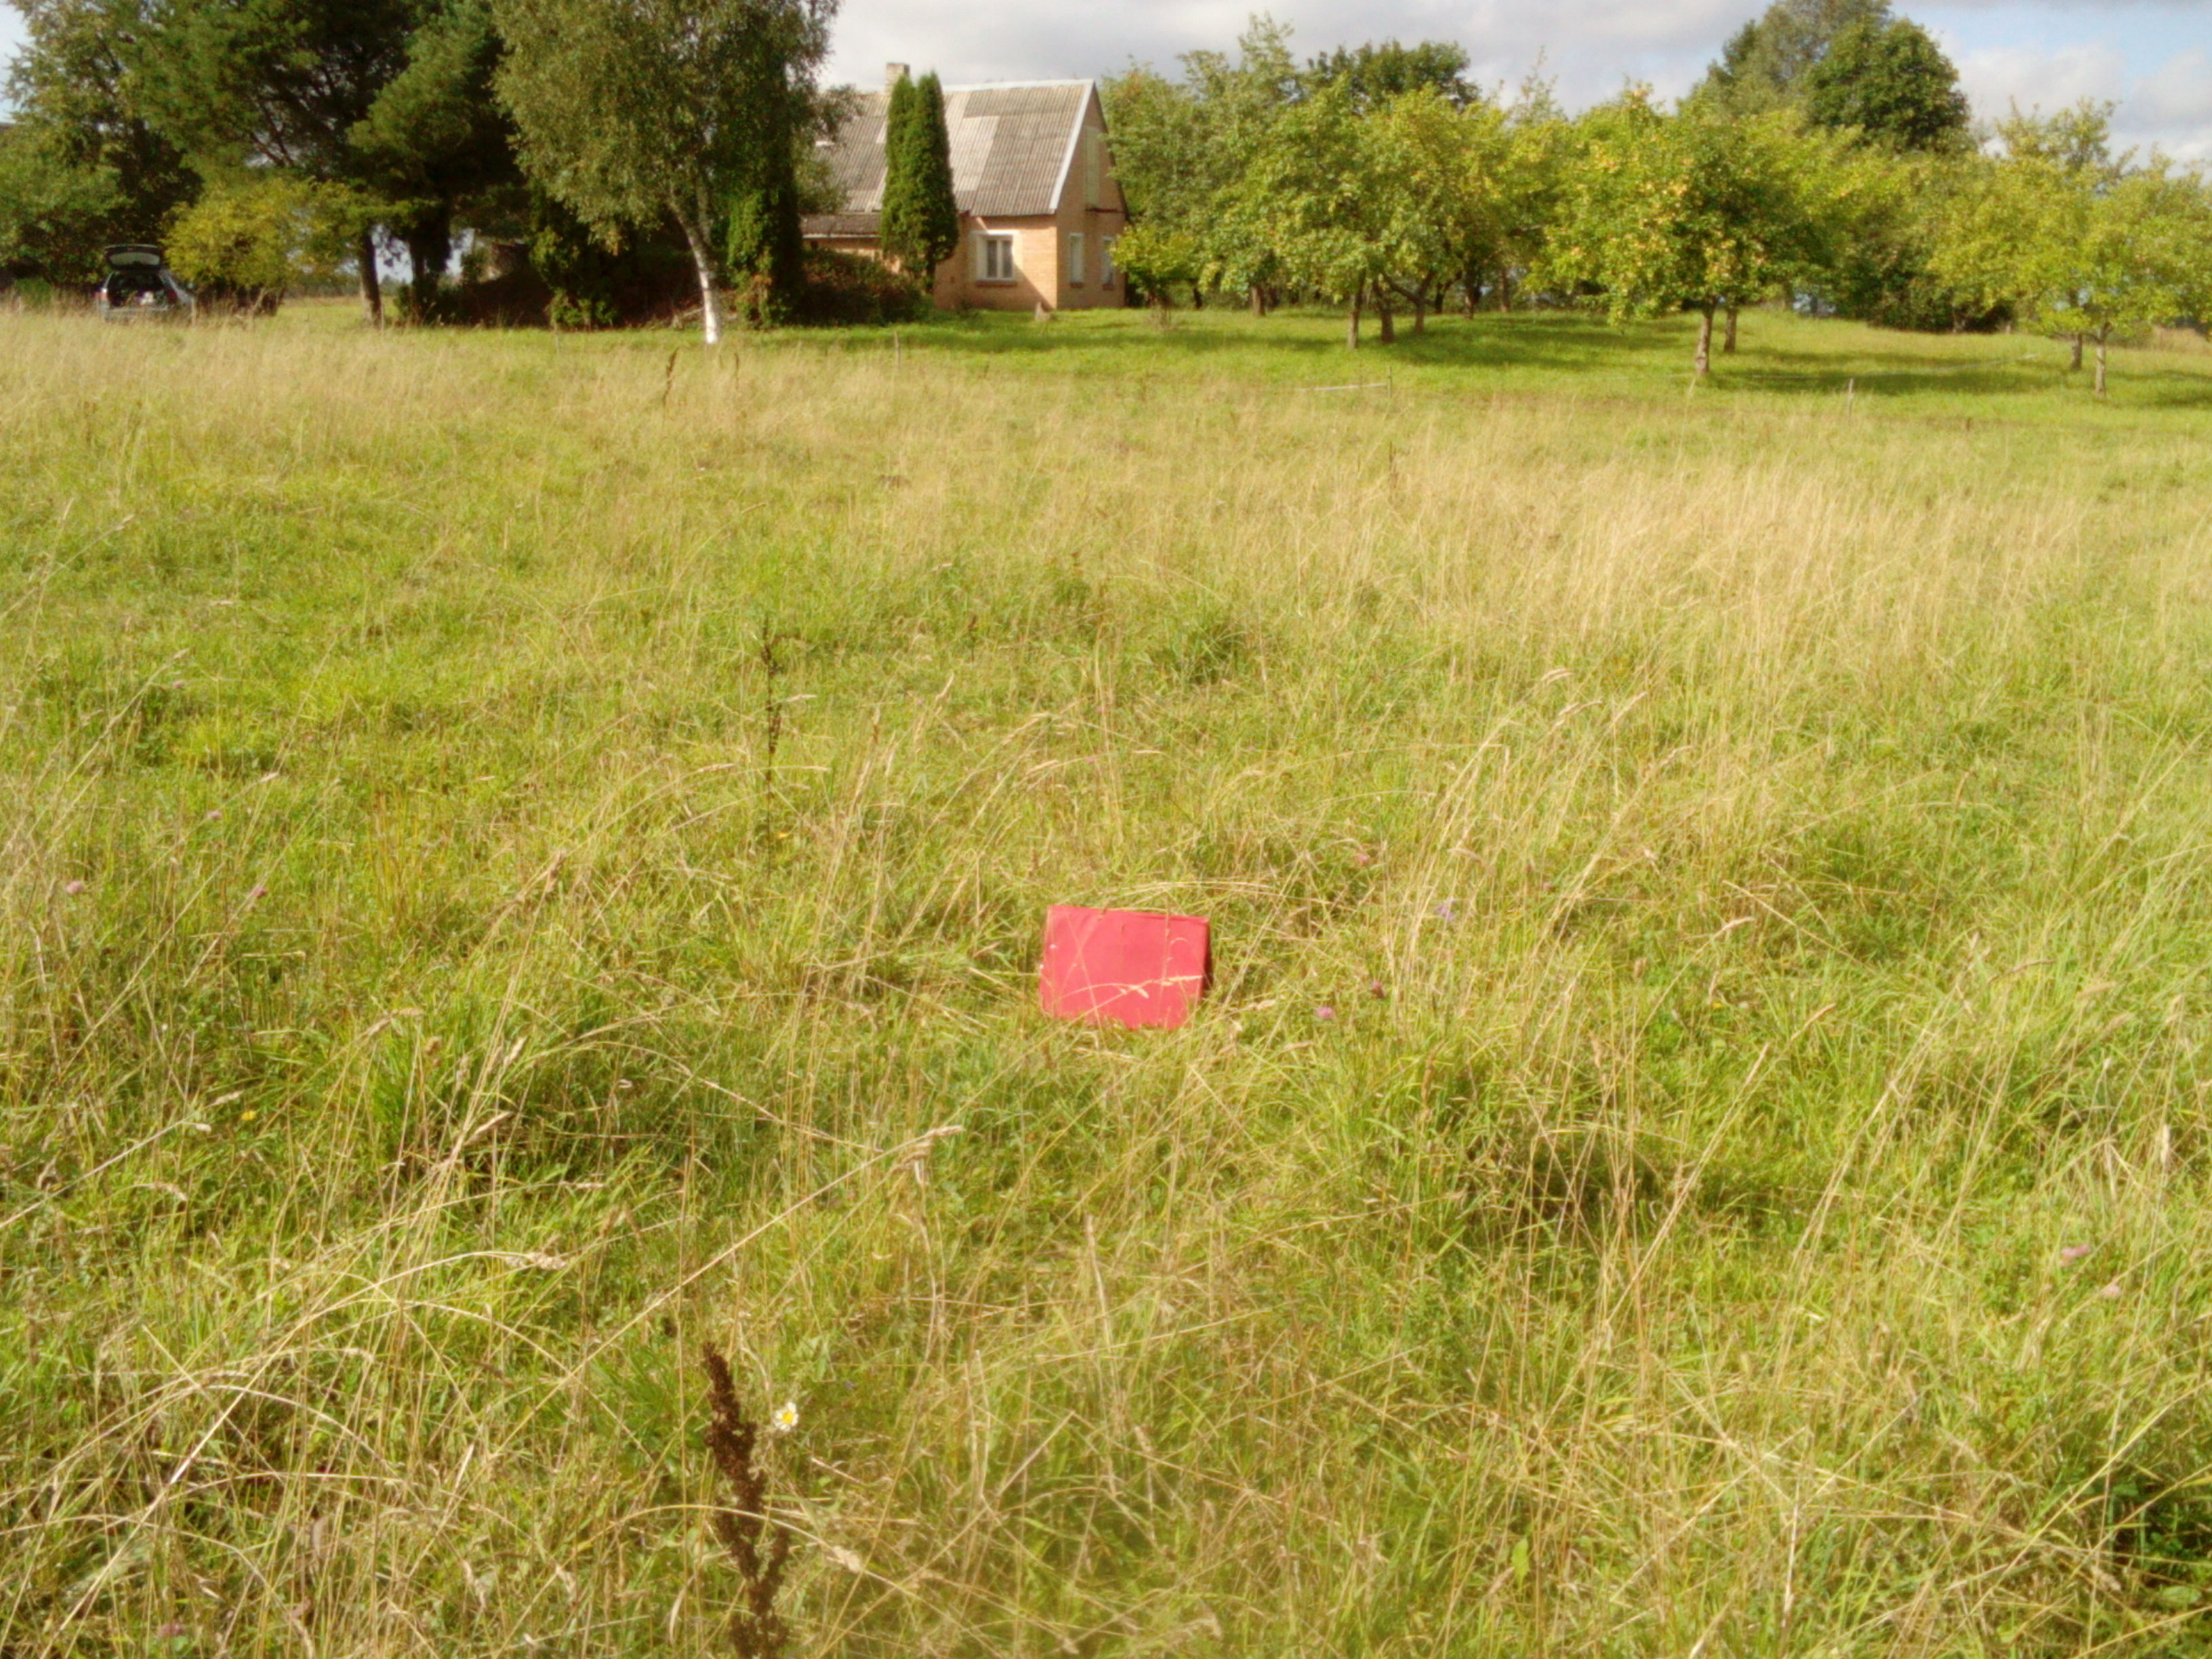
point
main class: Grassland
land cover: Grassland without tree/shrub cover
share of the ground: > 75 %
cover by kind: herbaceous plants 100 %
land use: Agriculture (excluding fallow land and kitchen gardens)
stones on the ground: < 10 %
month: September
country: LT
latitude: 55.9242
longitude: 22.8196
